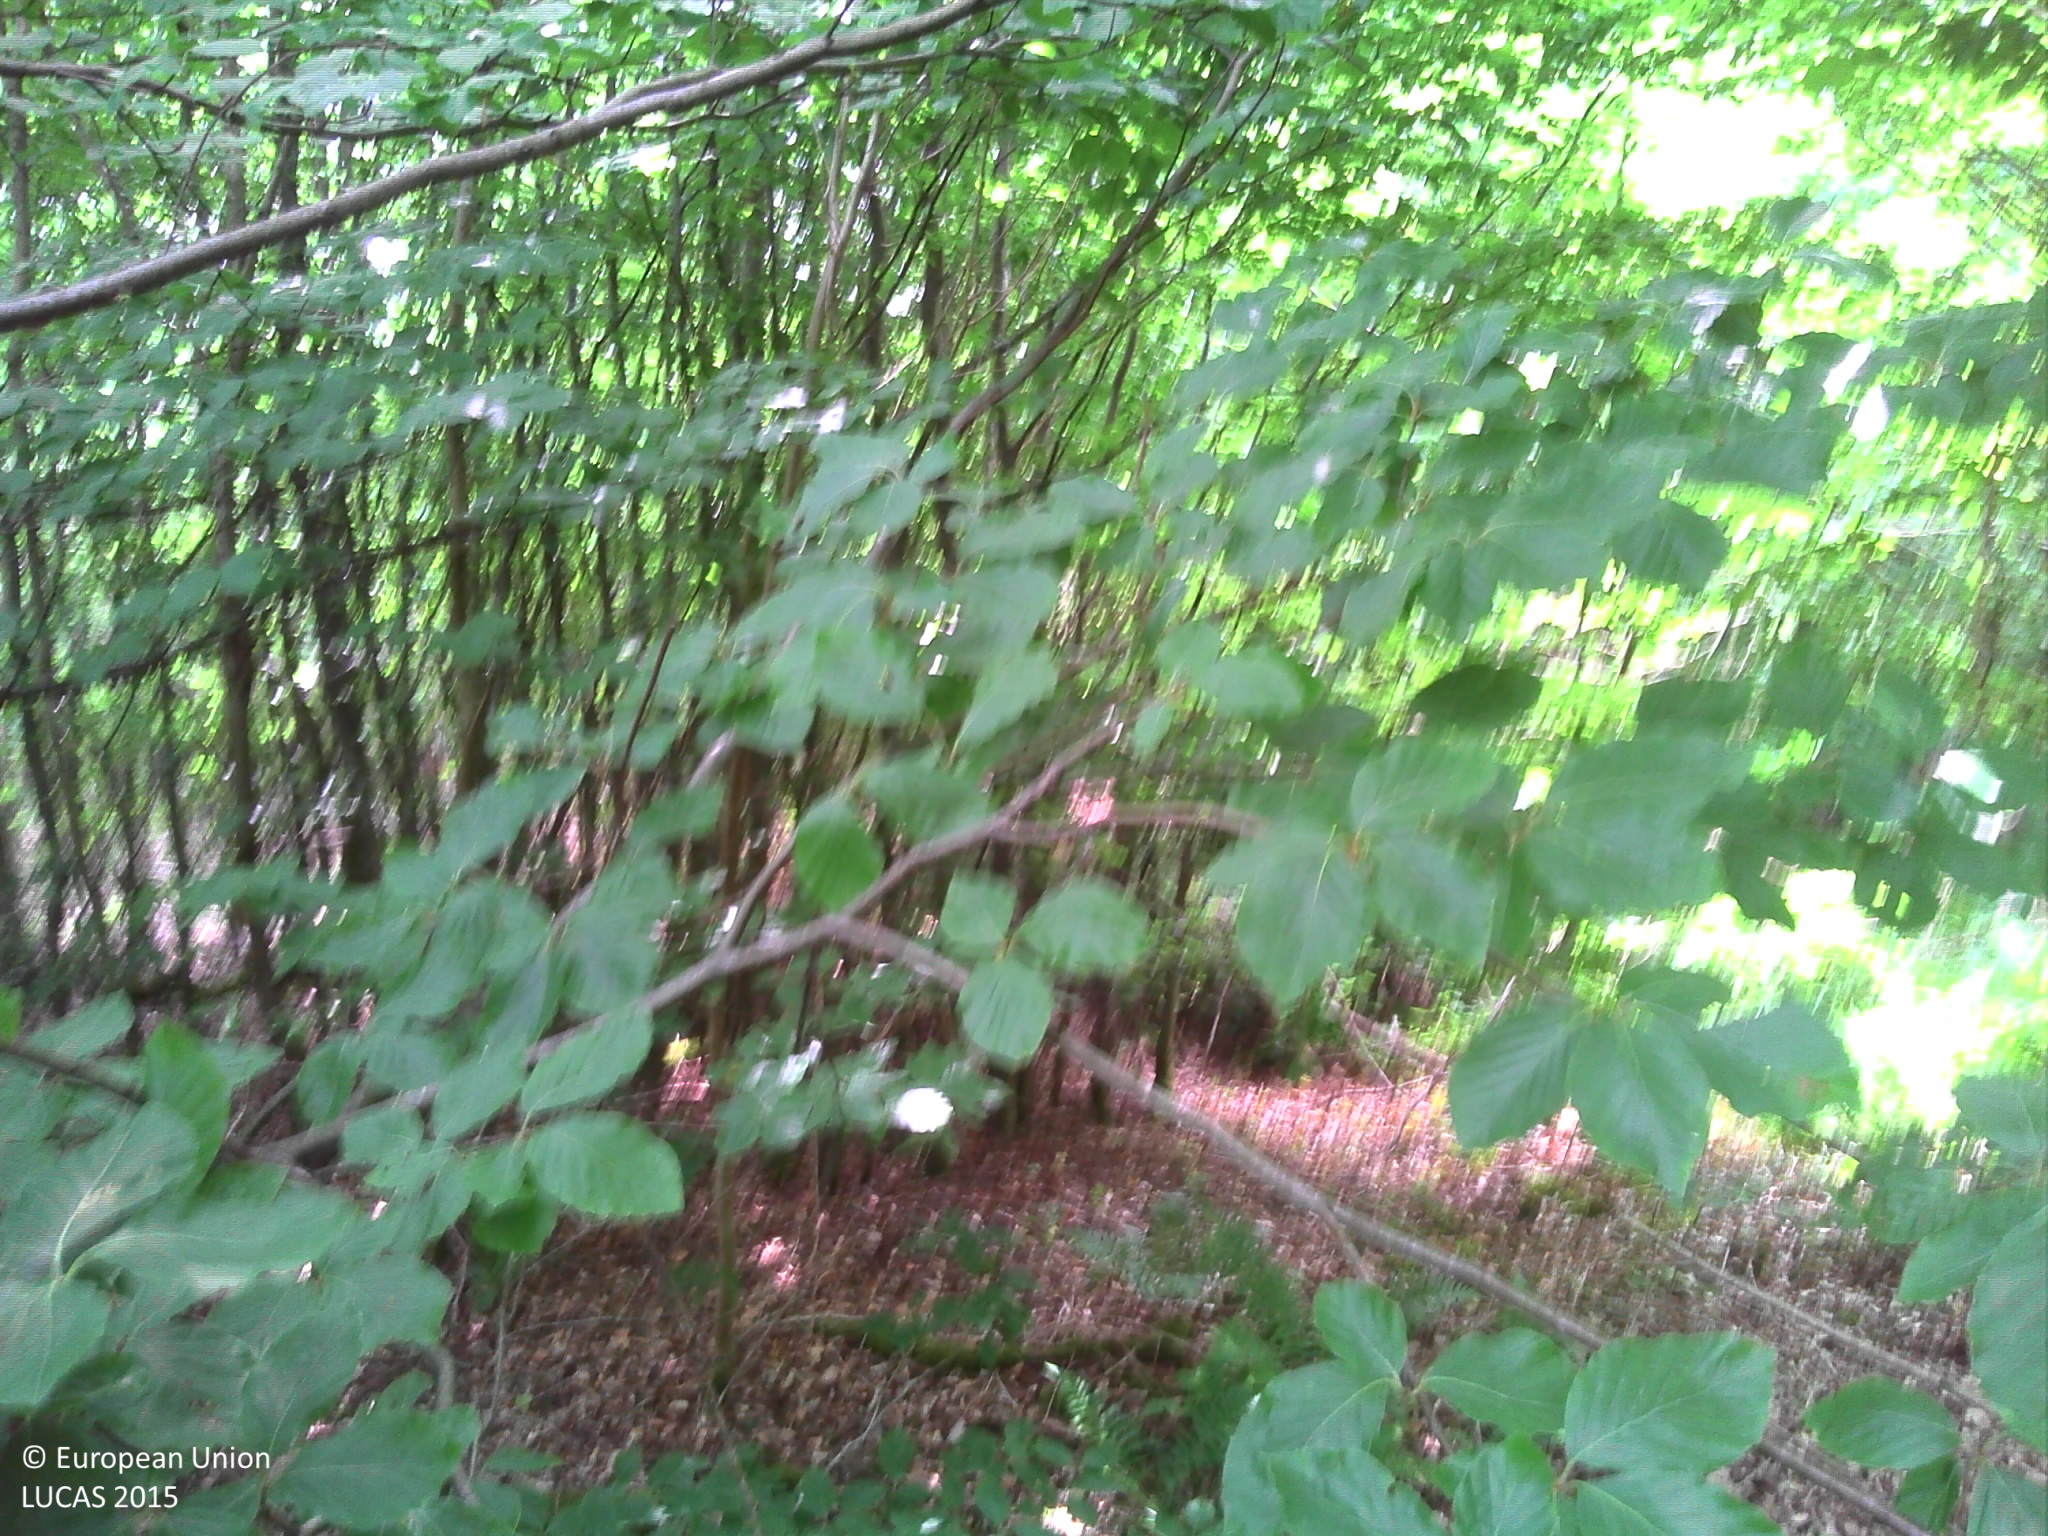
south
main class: Woodland
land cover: Broadleaved woodland
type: mesophytic deciduous forest
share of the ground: > 75 %
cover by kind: broadleaved forest trees 95 %, lichens and mosses 5 %
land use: Forestry
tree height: > 5 m
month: June
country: FR
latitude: 48.5371
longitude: 6.2215
